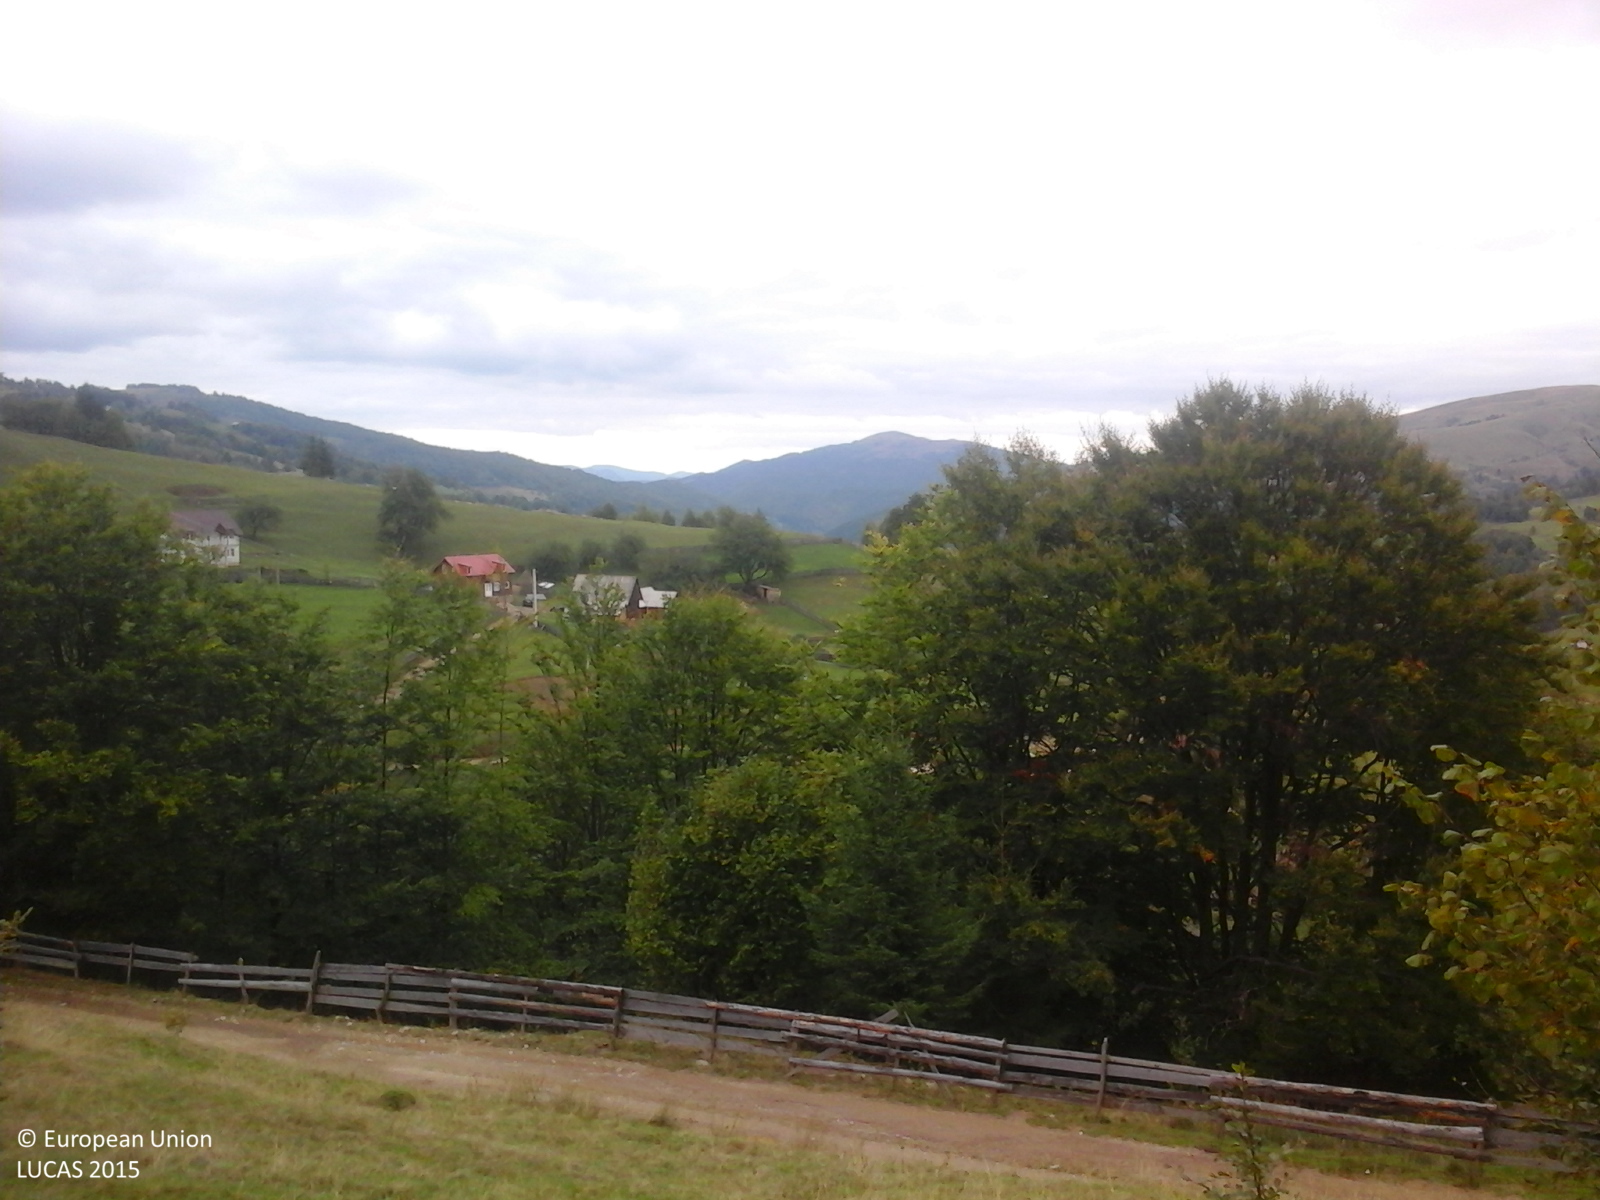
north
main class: Woodland
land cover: Other mixed woodland
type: beech forest
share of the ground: > 75 %
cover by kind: herbaceous plants 40 %, broadleaved forest trees 35 %, coniferous forest trees 25 %
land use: Forestry
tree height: > 5 m
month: September
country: RO
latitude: 46.6979
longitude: 22.8879
